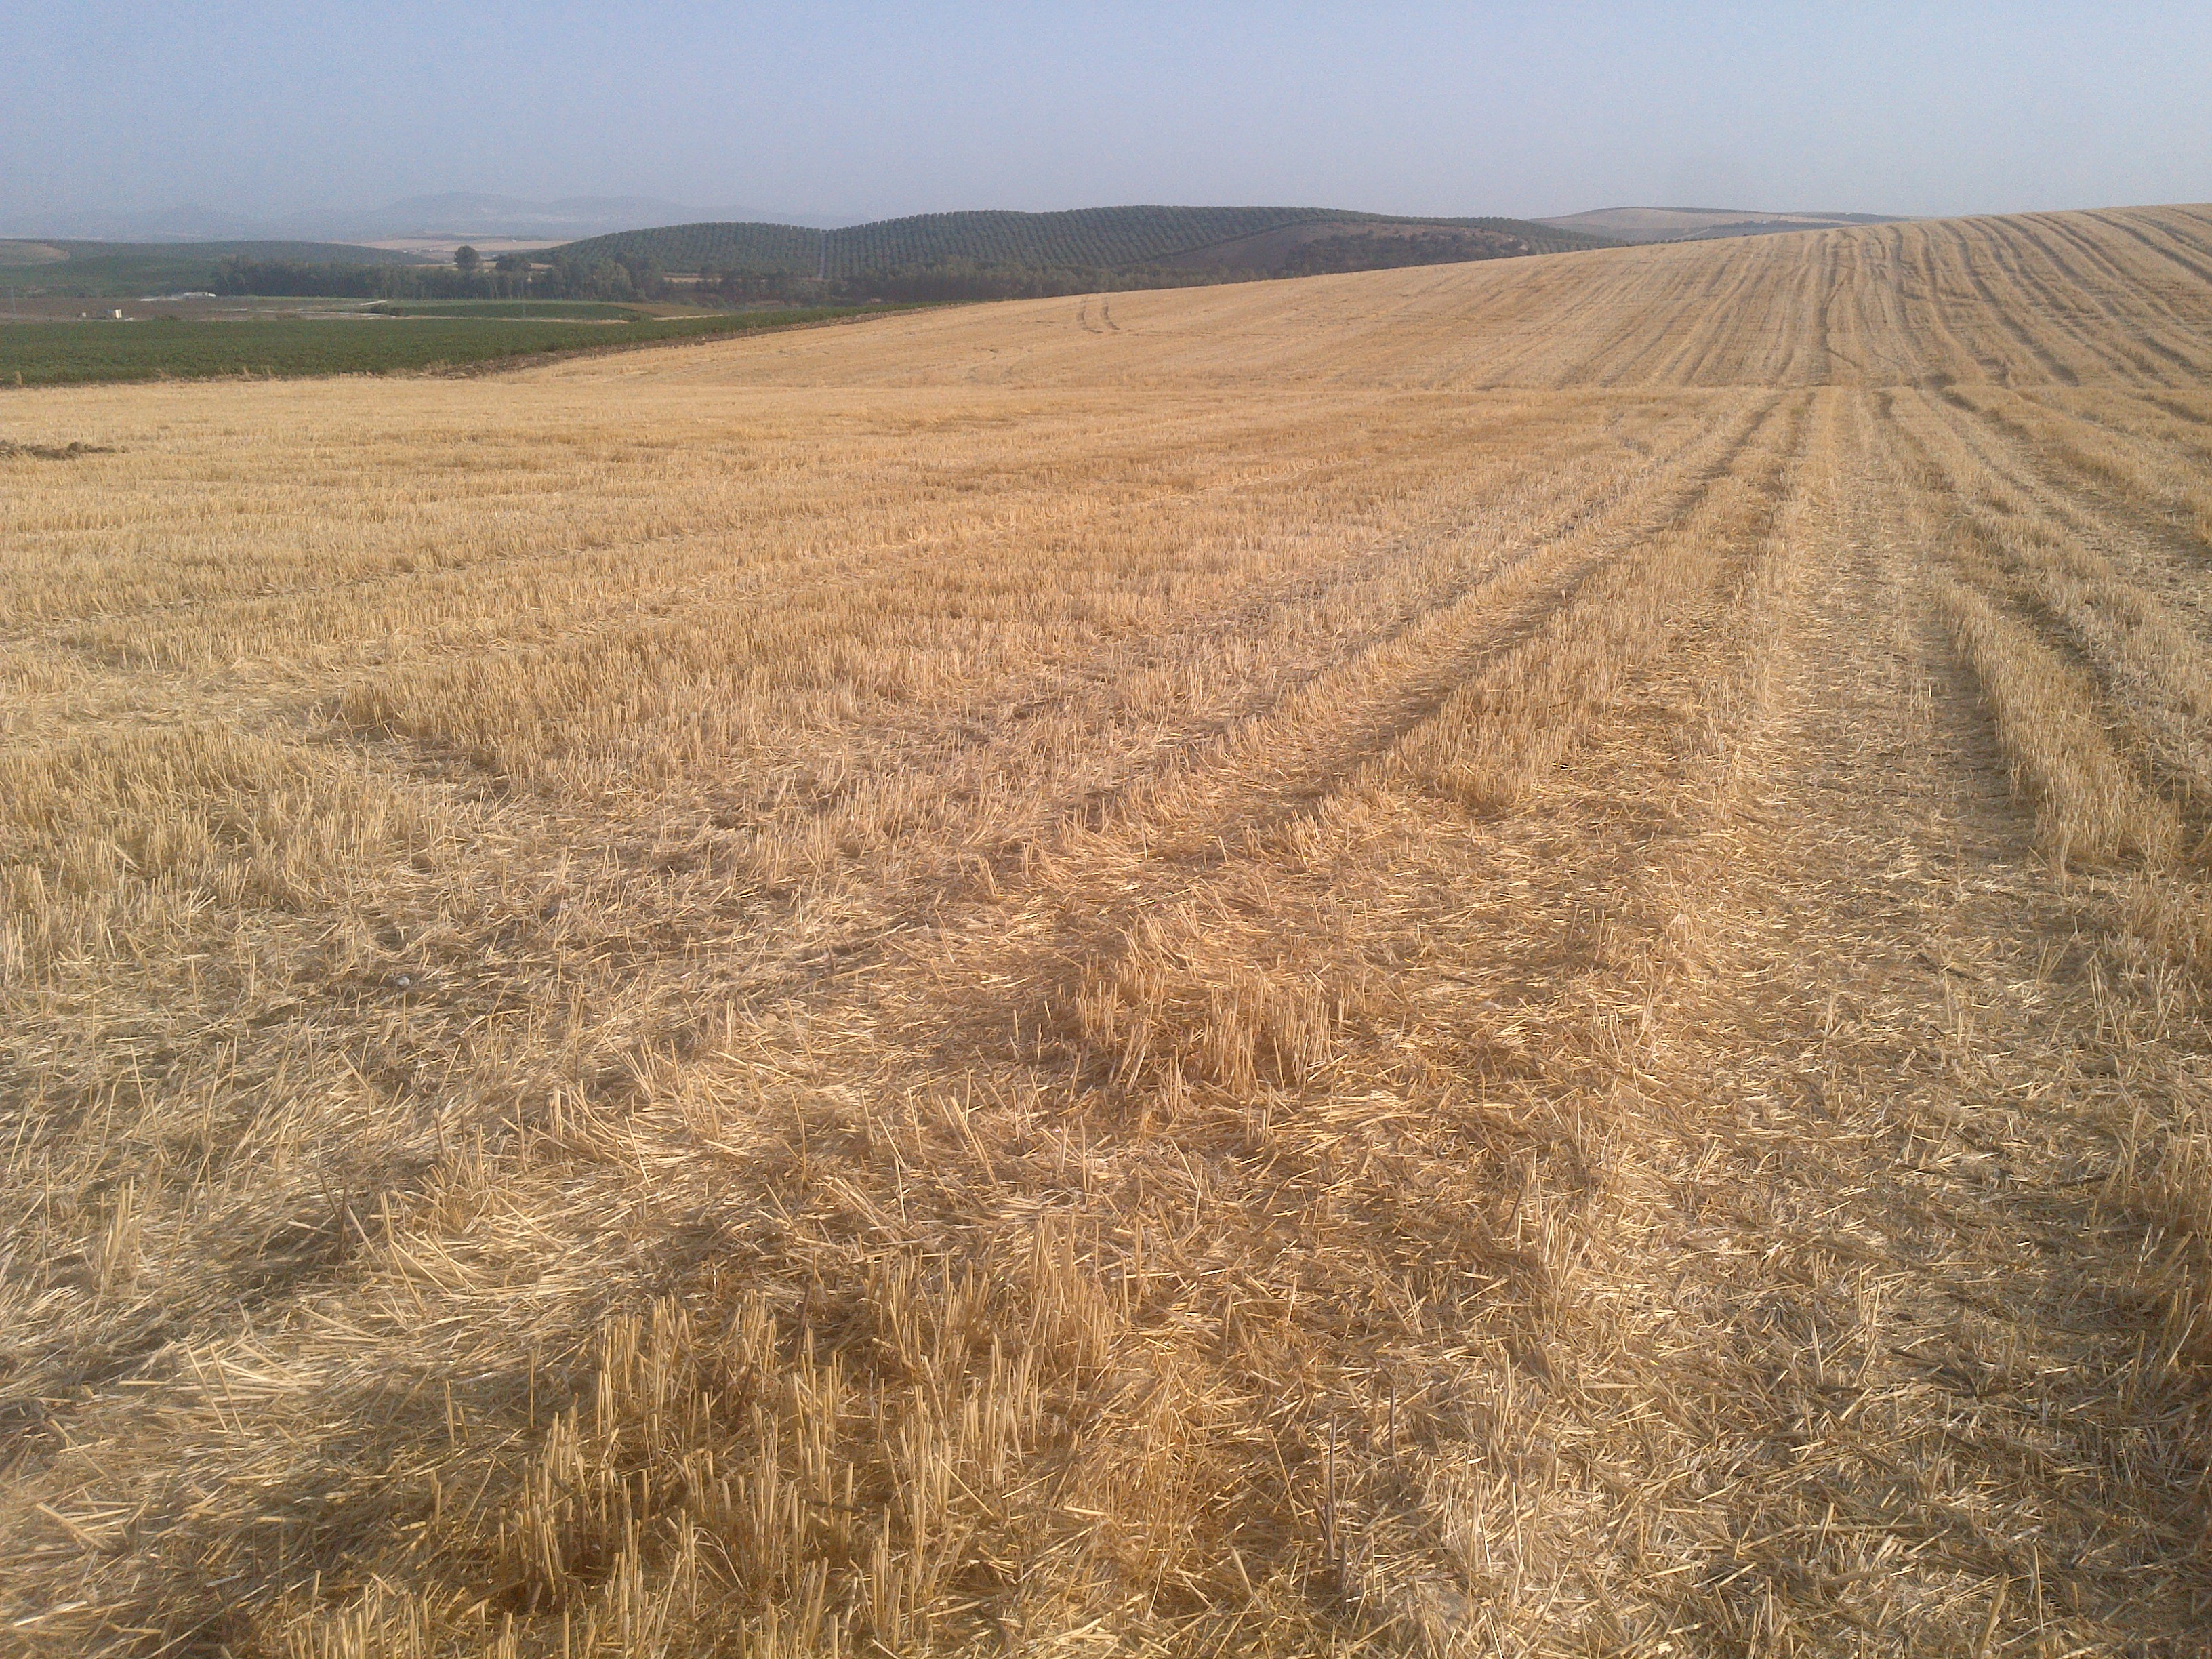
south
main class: Cropland
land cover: Durum wheat
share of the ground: < 10 %
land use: Agriculture (excluding fallow land and kitchen gardens)
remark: Harvested field
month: July
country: ES
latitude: 37.5215
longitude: -4.9115
